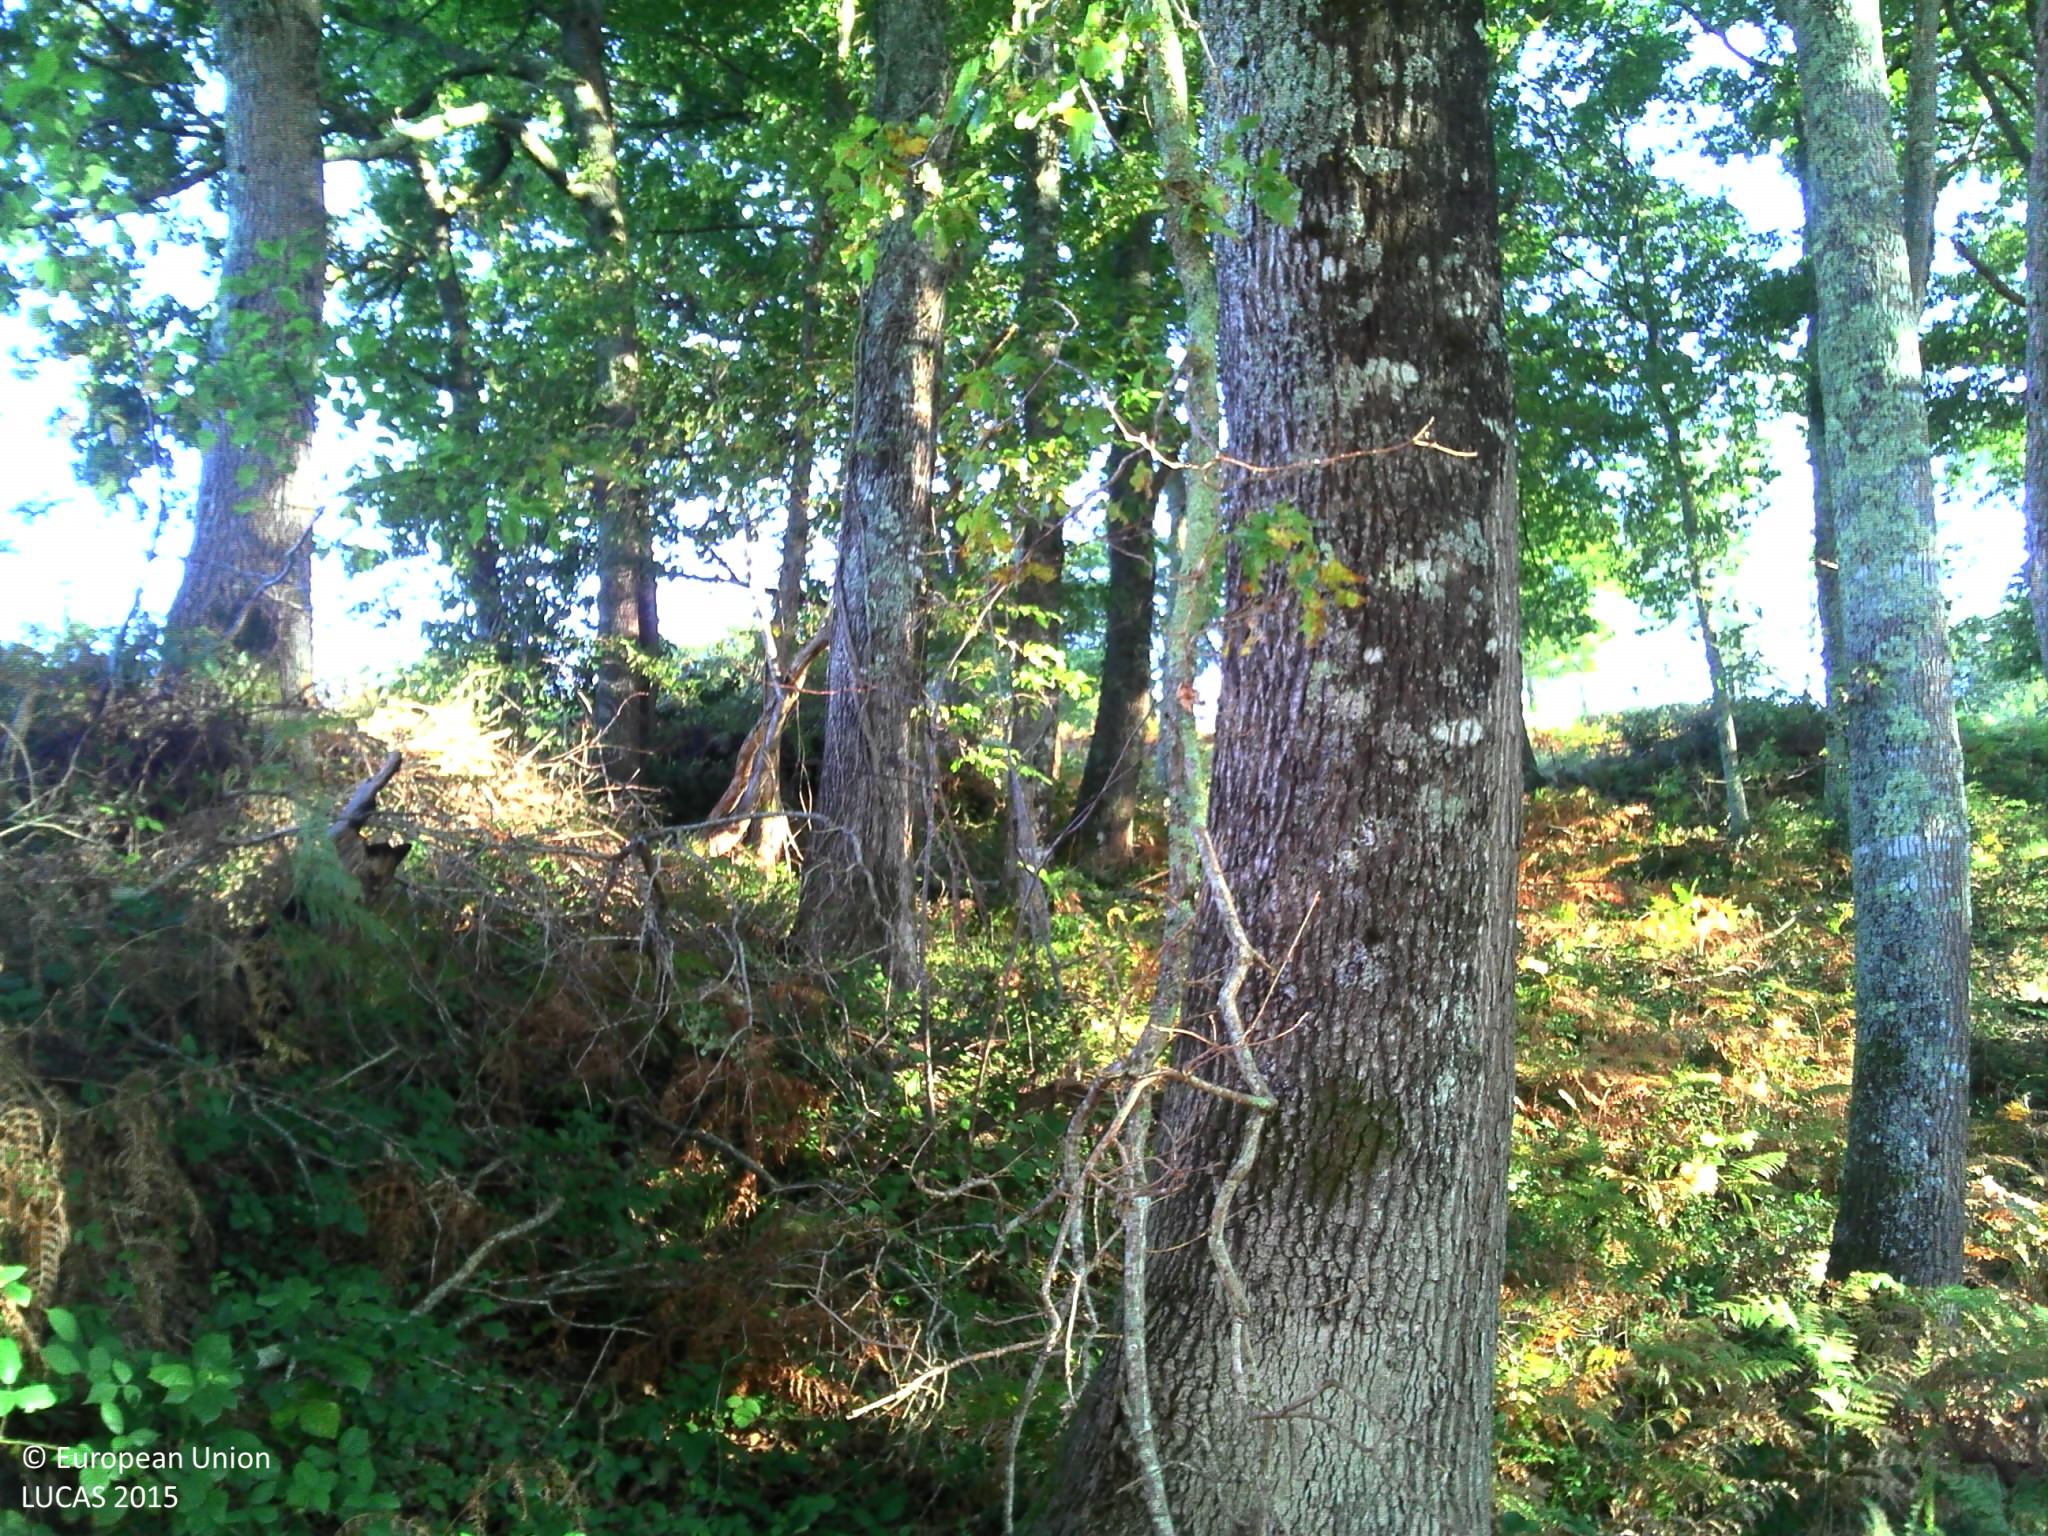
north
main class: Woodland
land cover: Broadleaved woodland
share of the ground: 50 - 75 %
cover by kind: broadleaved forest trees 65 %, herbaceous plants 20 %, shrubs 10 %, lichens and mosses 5 %
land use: Forestry
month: September
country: FR
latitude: 43.1979
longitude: -0.6781
